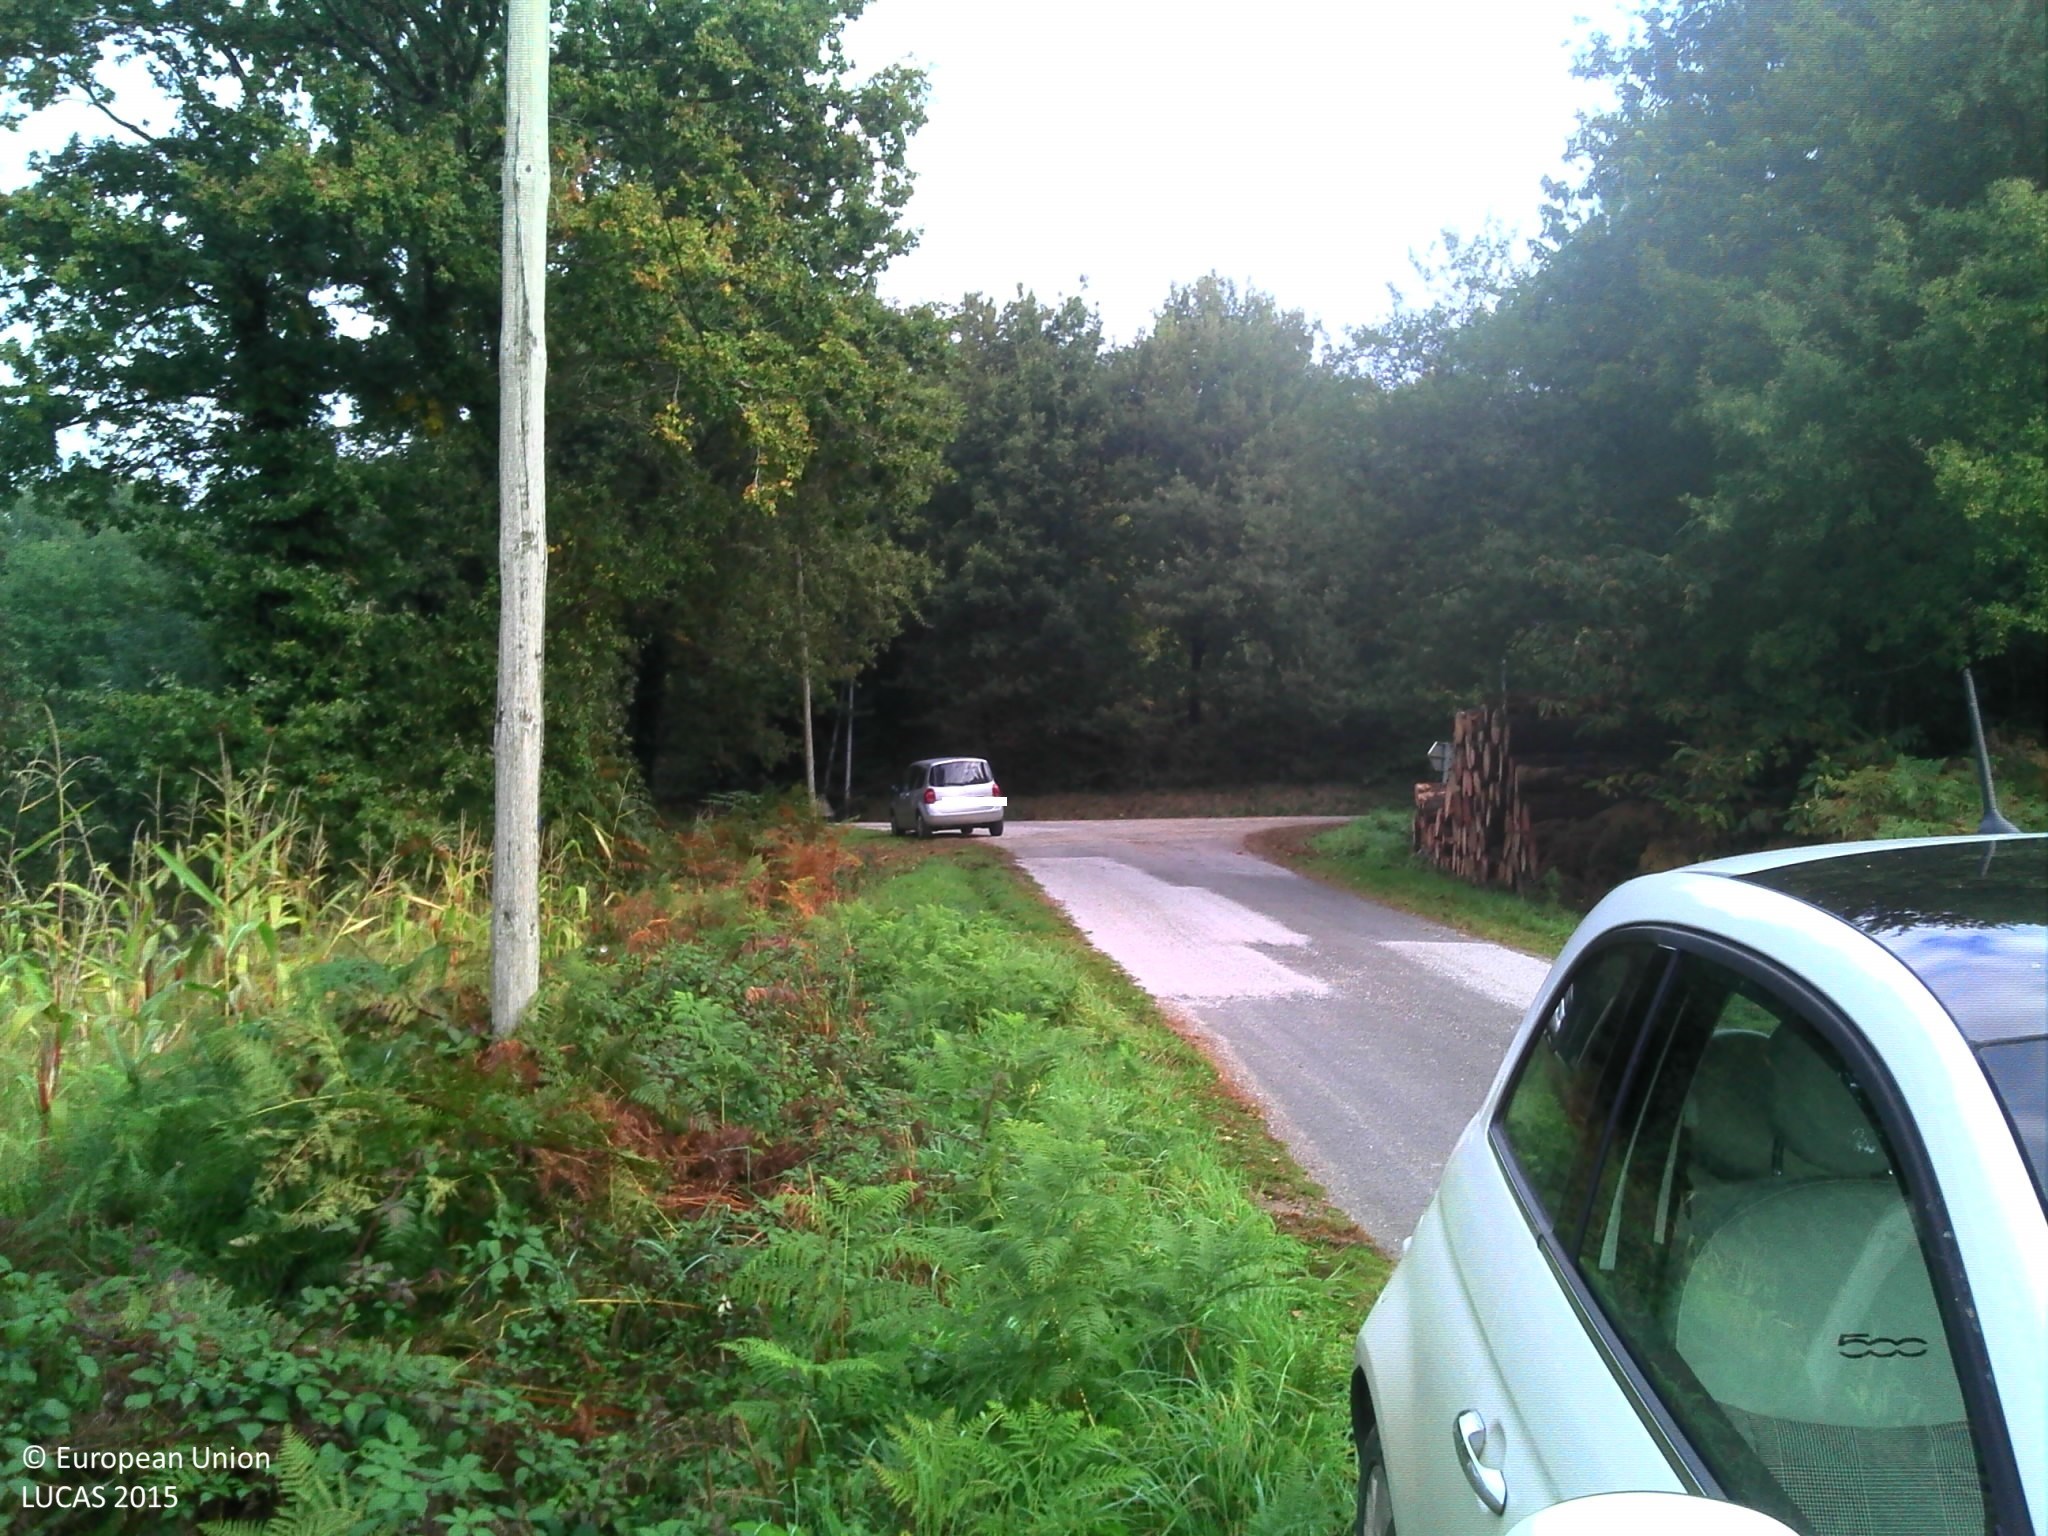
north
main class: Cropland
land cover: Maize
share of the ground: > 75 %
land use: Agriculture (excluding fallow land and kitchen gardens)
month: October
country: FR
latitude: 47.6246
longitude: -2.2831
